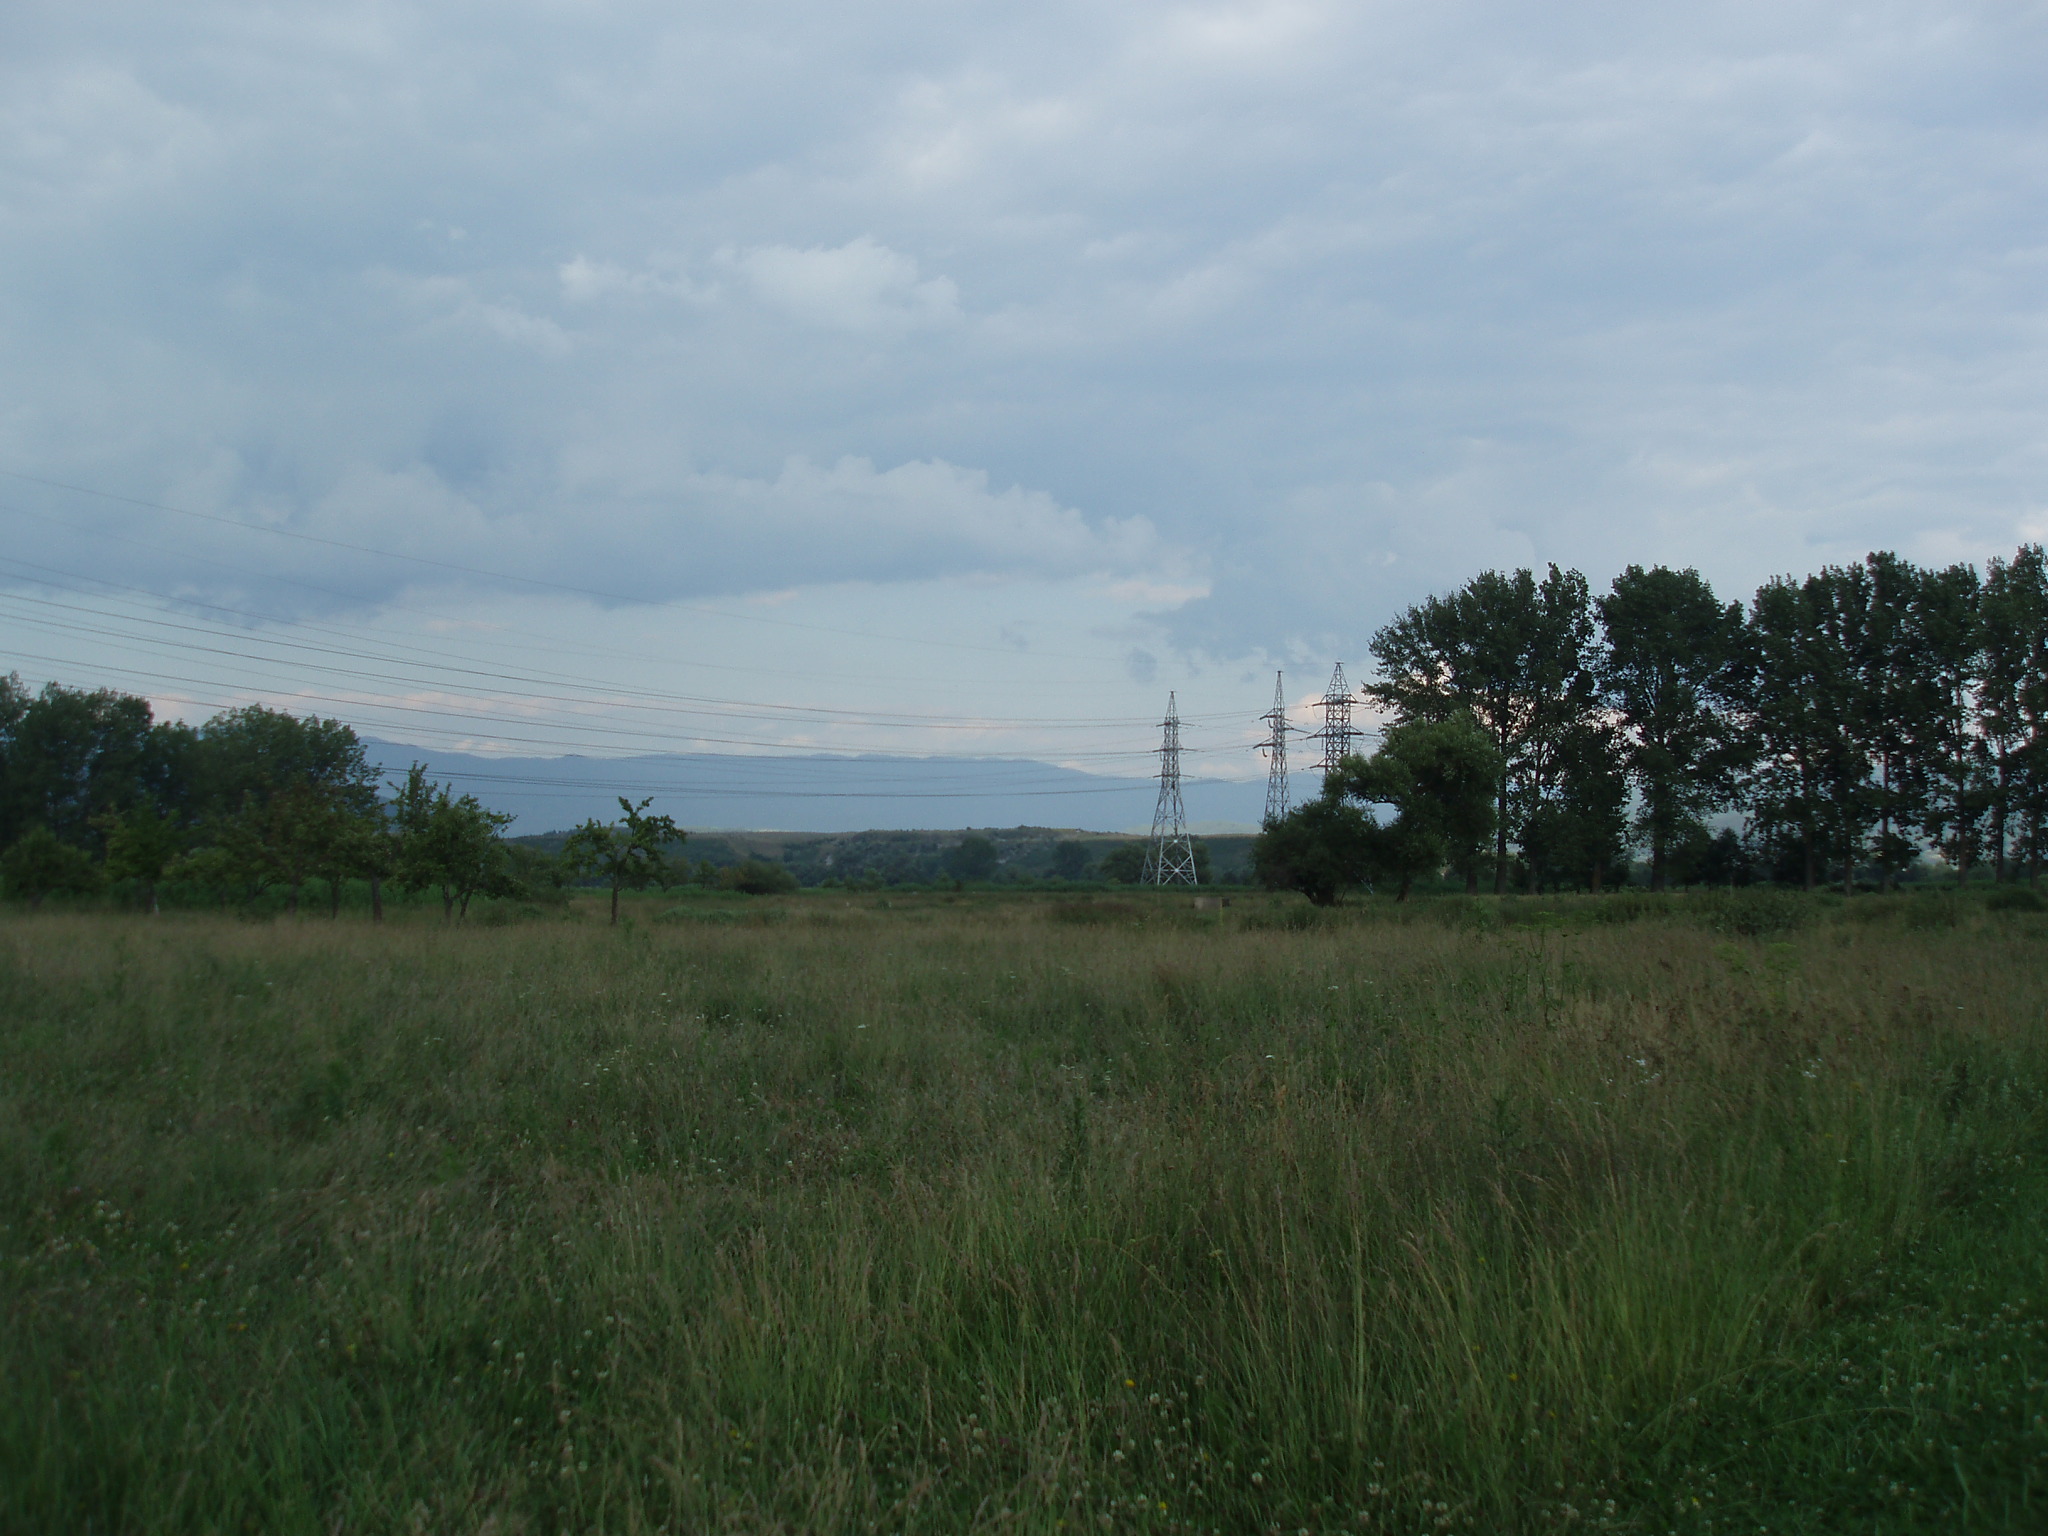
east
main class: Artificial land
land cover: Other artificial areas
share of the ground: > 75 %
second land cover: Grassland without tree/shrub cover
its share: > 75 %
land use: Electricity, gas and thermal power distribution
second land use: Agriculture (excluding fallow land and kitchen gardens)
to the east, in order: Artificial constructions in urban areas; Grassland without tree/shrub cover; Abandoned hedges; Ditches and canals; Abandoned hedges; Grassland with sparse tree/shrub cover; Other bare soil; Grassland with sparse tree/shrub cover; Ditches and canals; Grassland without tree/shrub cover; Electric lines; Grassland without tree/shrub cover
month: July
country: BG
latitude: 41.8366
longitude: 23.5030
